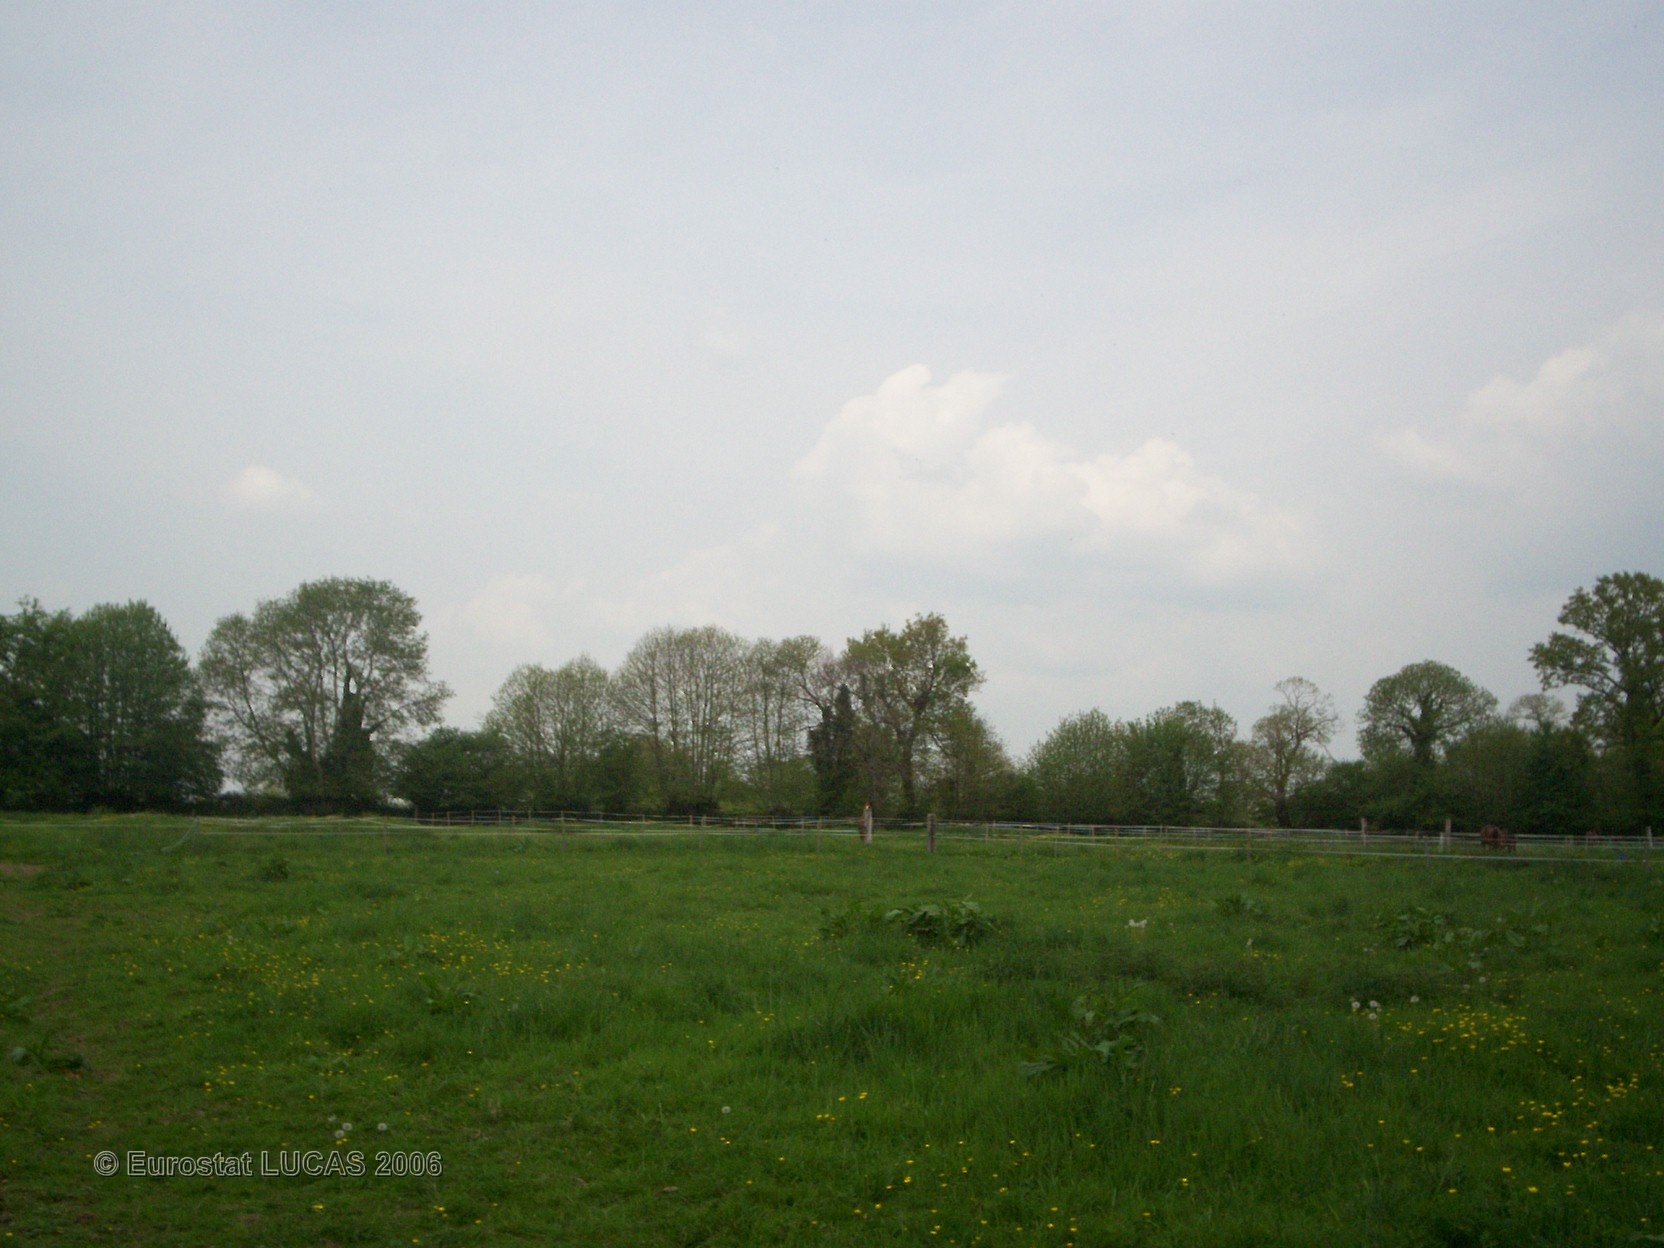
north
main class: Grassland
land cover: Grassland without tree/shrub cover
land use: Agriculture (excluding fallow land and kitchen gardens)
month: May
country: FR
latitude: 48.7794
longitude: -1.3548
